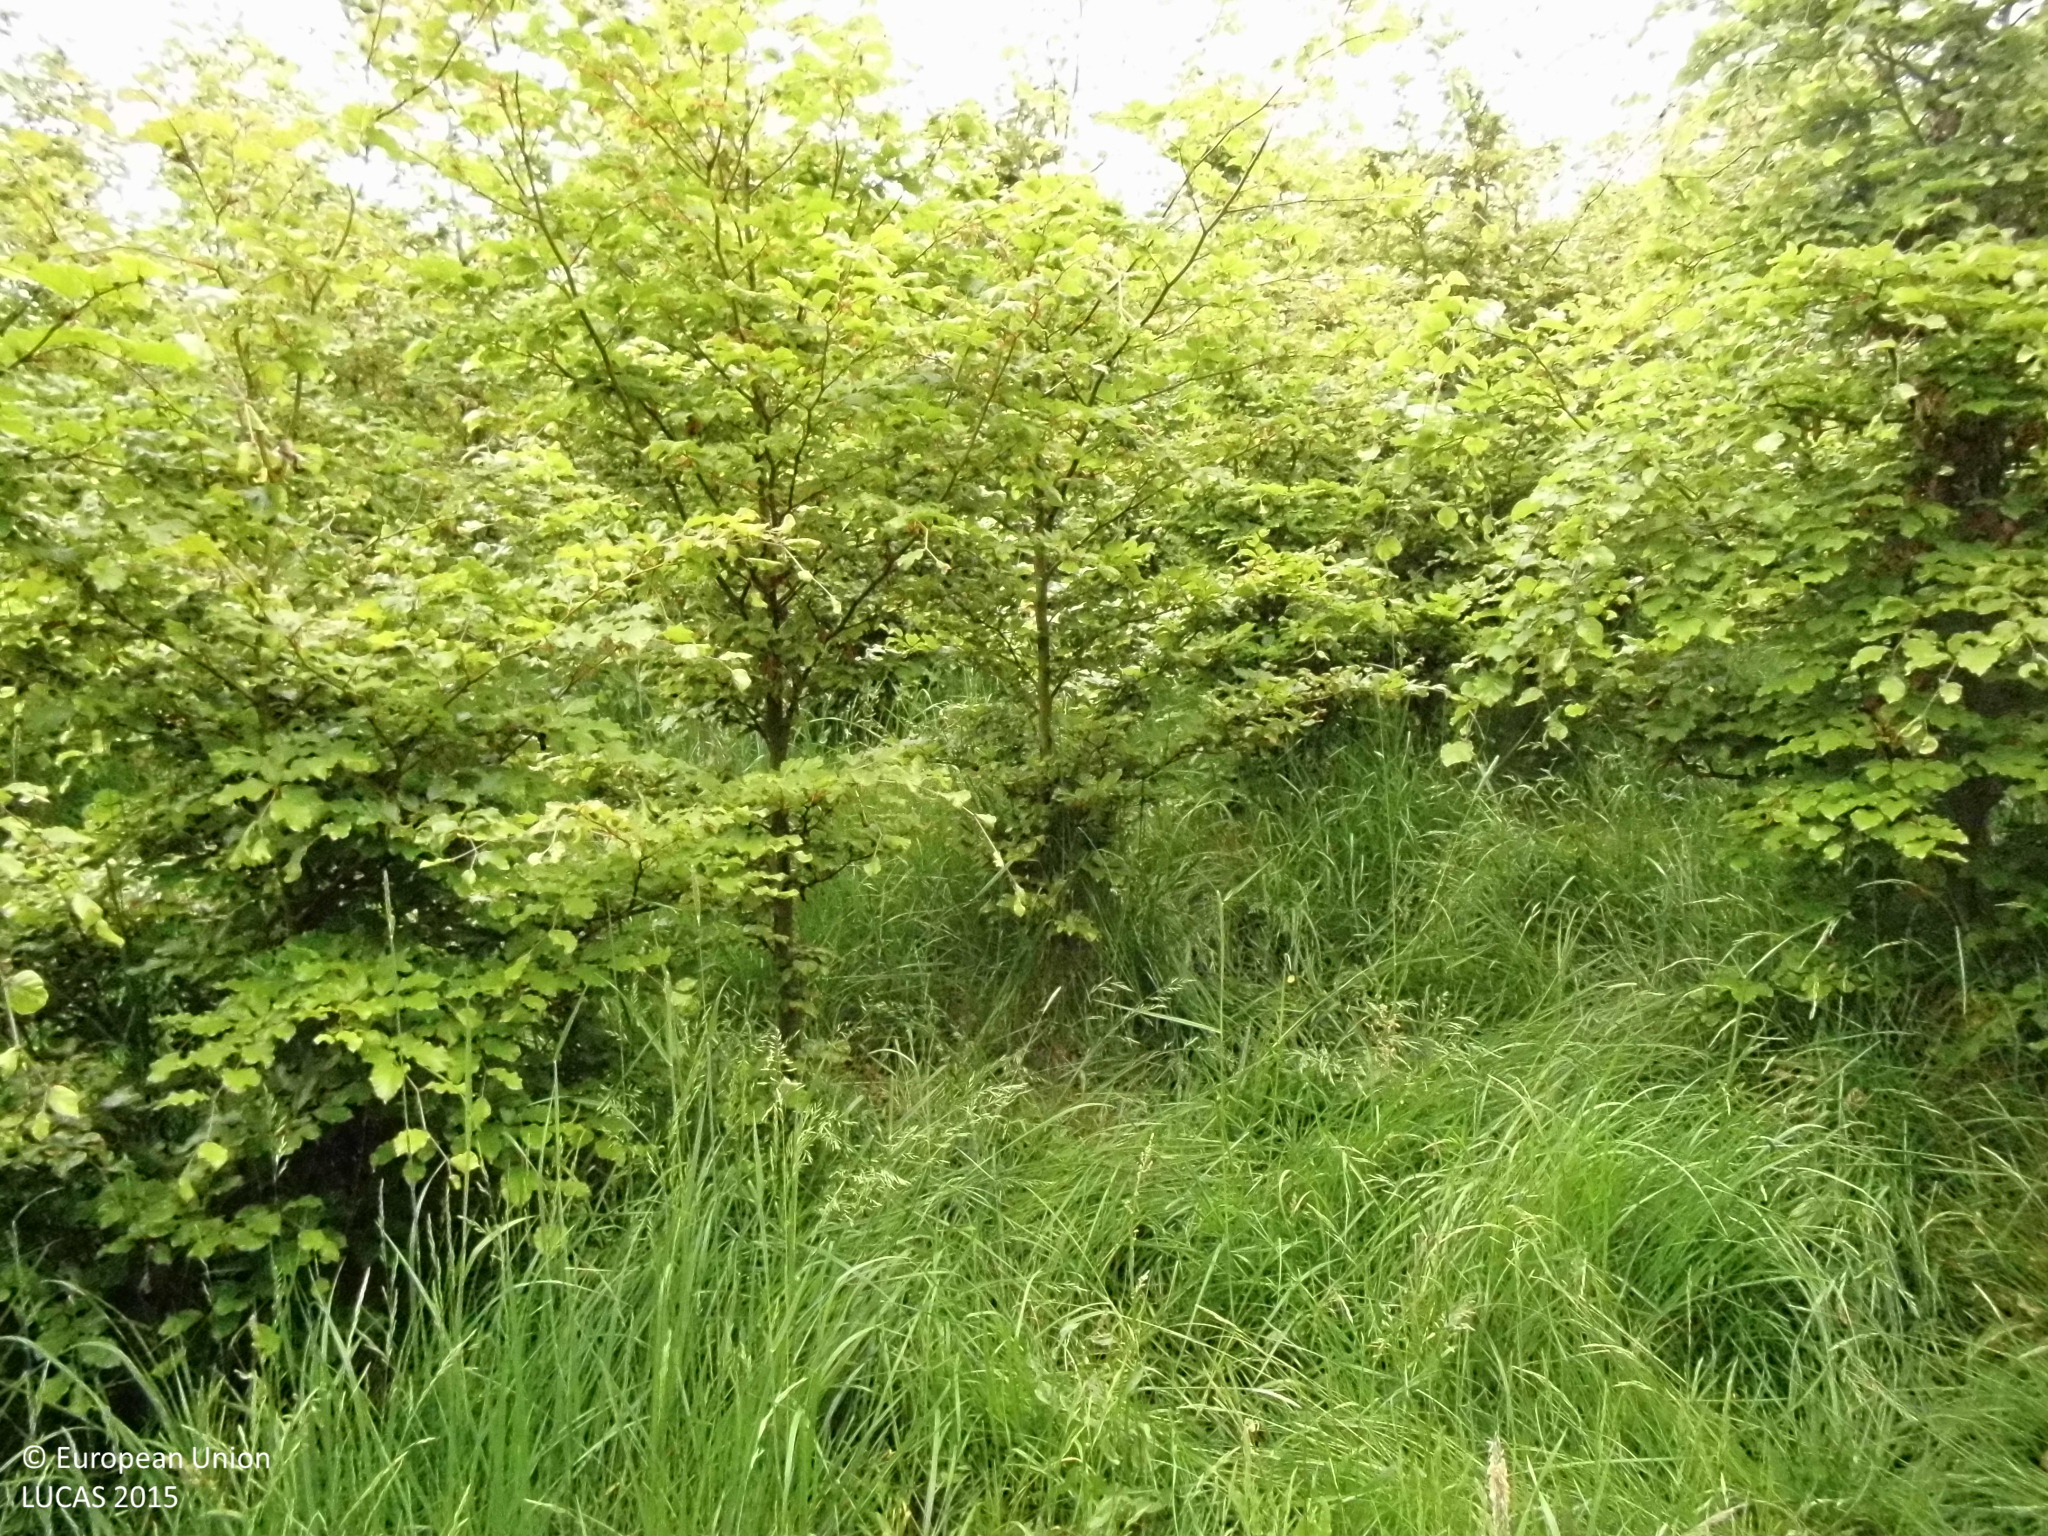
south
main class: Woodland
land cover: Broadleaved woodland
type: mesophytic deciduous forest
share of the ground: 50 - 75 %
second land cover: Grassland without tree/shrub cover
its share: > 75 %
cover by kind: broadleaved forest trees 65 %, herbaceous plants 35 %
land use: Forestry
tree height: < 5 m
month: May
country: DE
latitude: 50.8947
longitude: 7.5122
